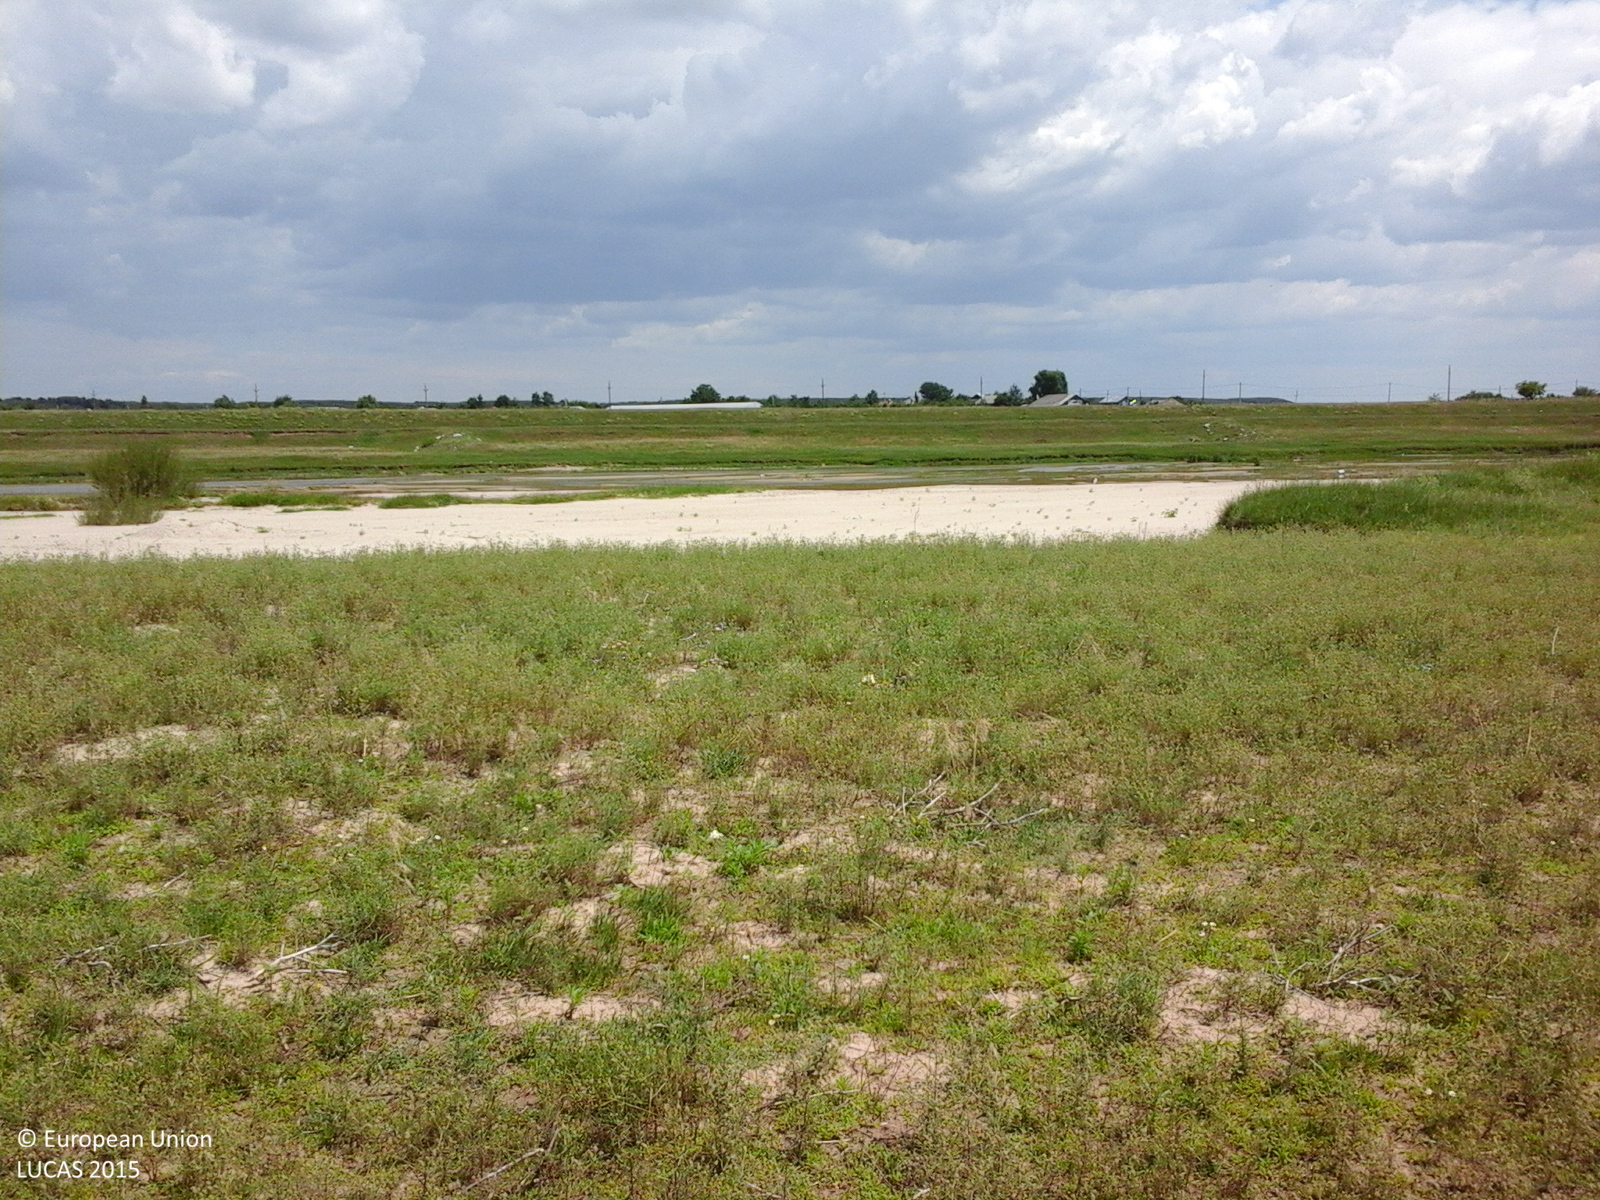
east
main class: Grassland
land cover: Spontaneously vegetated surfaces
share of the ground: > 75 %
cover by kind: herbaceous plants 100 %
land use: Agriculture (excluding fallow land and kitchen gardens)
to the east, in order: Spontaneously vegetated surfaces; Sand; Grass margins; Sand; Inland fresh running water; Grassland without tree/shrub cover; Tracks; Grassland without tree/shrub cover; Arable land (only in case pi)
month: July
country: RO
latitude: 44.2931
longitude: 24.7754
